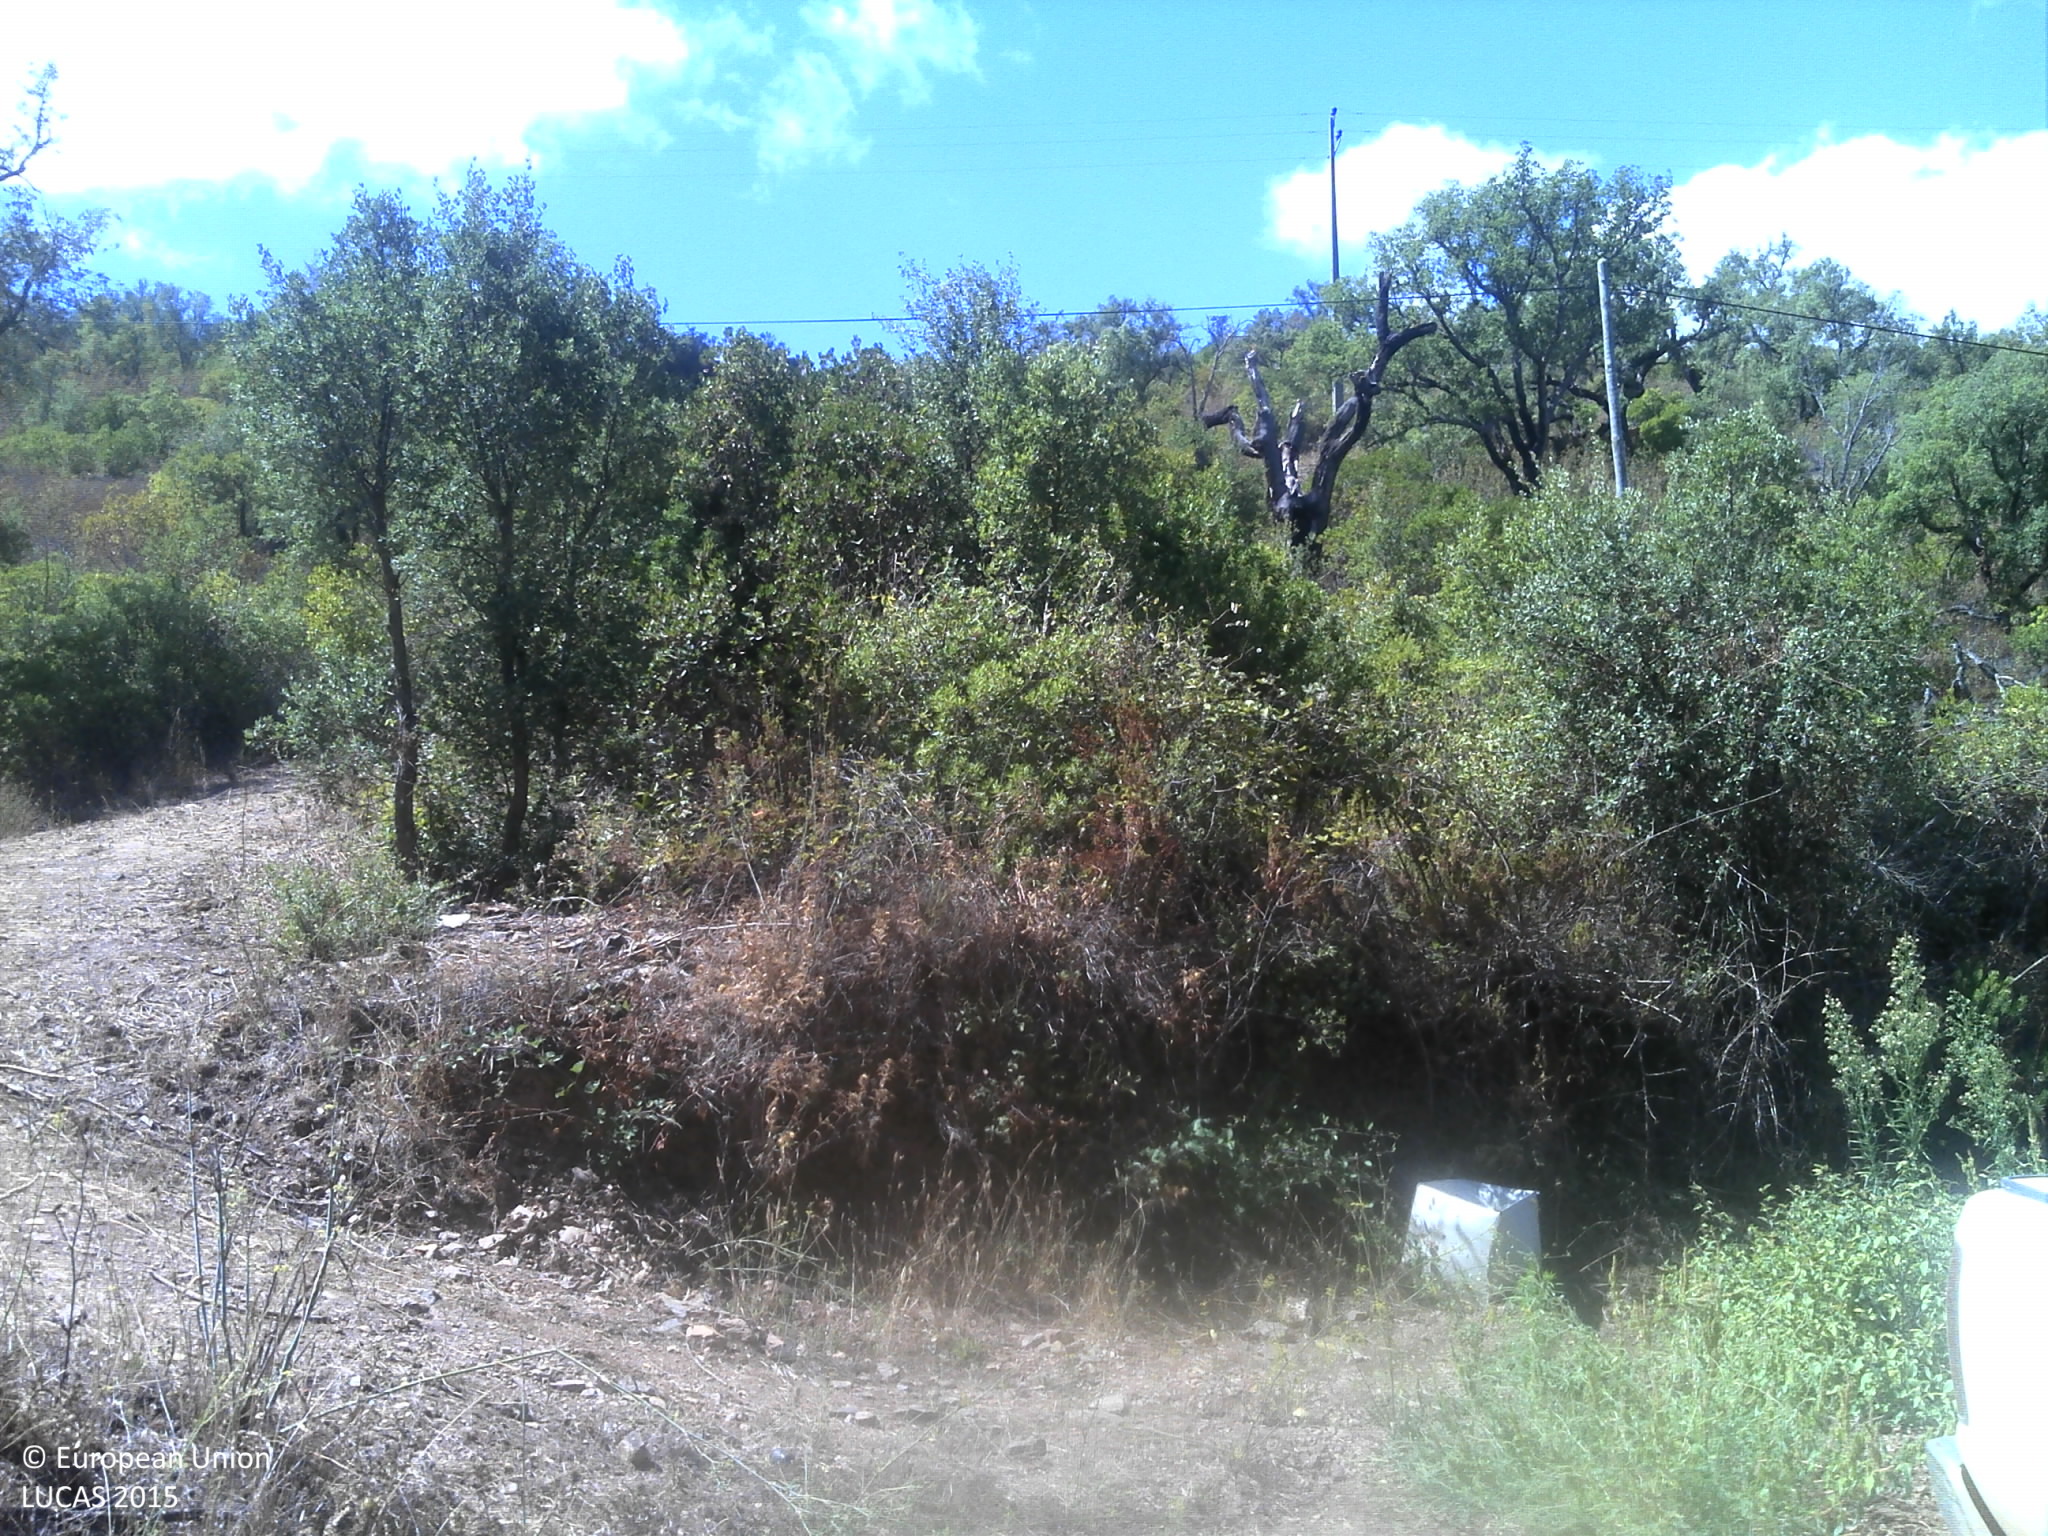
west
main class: Shrubland
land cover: Shrubland with sparse tree cover
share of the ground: > 75 %
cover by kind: shrubs 75 %, unconsolidated bare surface 20 %, broadleaved forest trees 5 %
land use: Abandoned areas
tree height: < 5 m
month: September
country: PT
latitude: 37.3093
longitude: -8.1977
